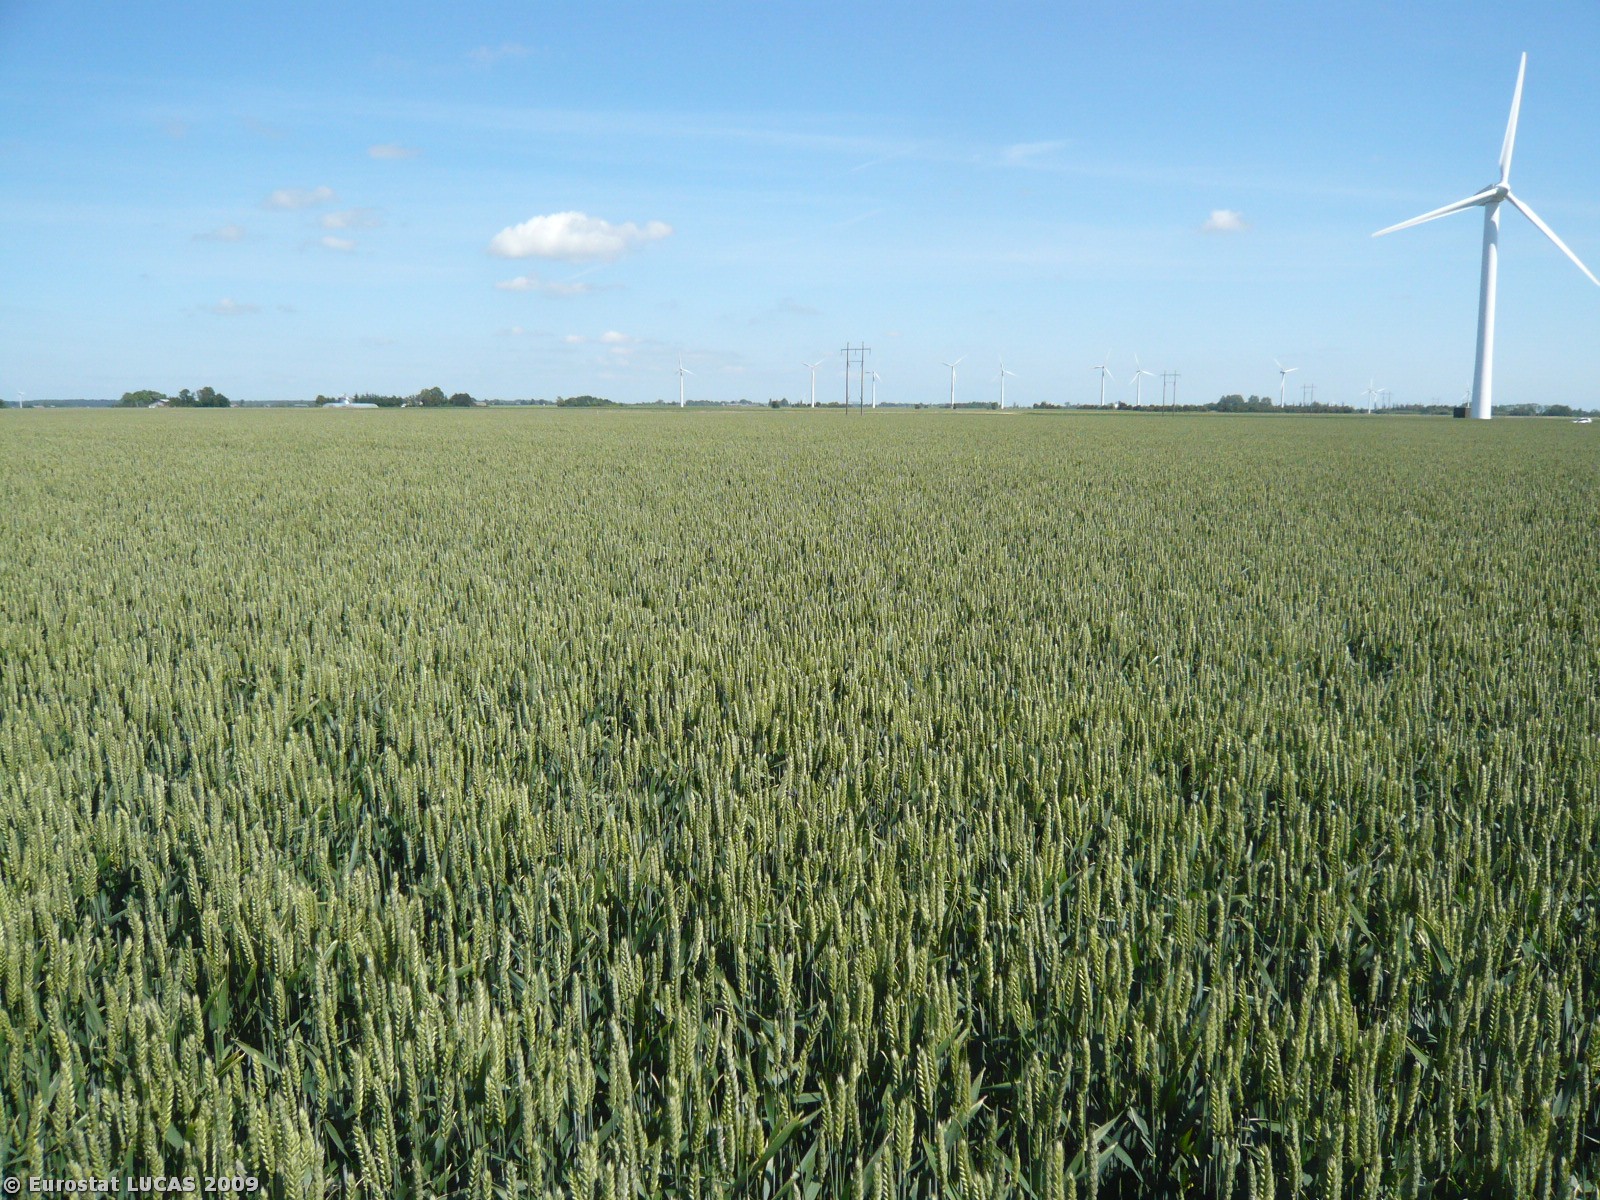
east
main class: Cropland
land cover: Common wheat
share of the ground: > 75 %
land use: Agriculture (excluding fallow land and kitchen gardens)
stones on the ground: < 10 %
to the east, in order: Common wheat; Electric lines
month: June
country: DK
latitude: 54.7435
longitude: 11.2574
